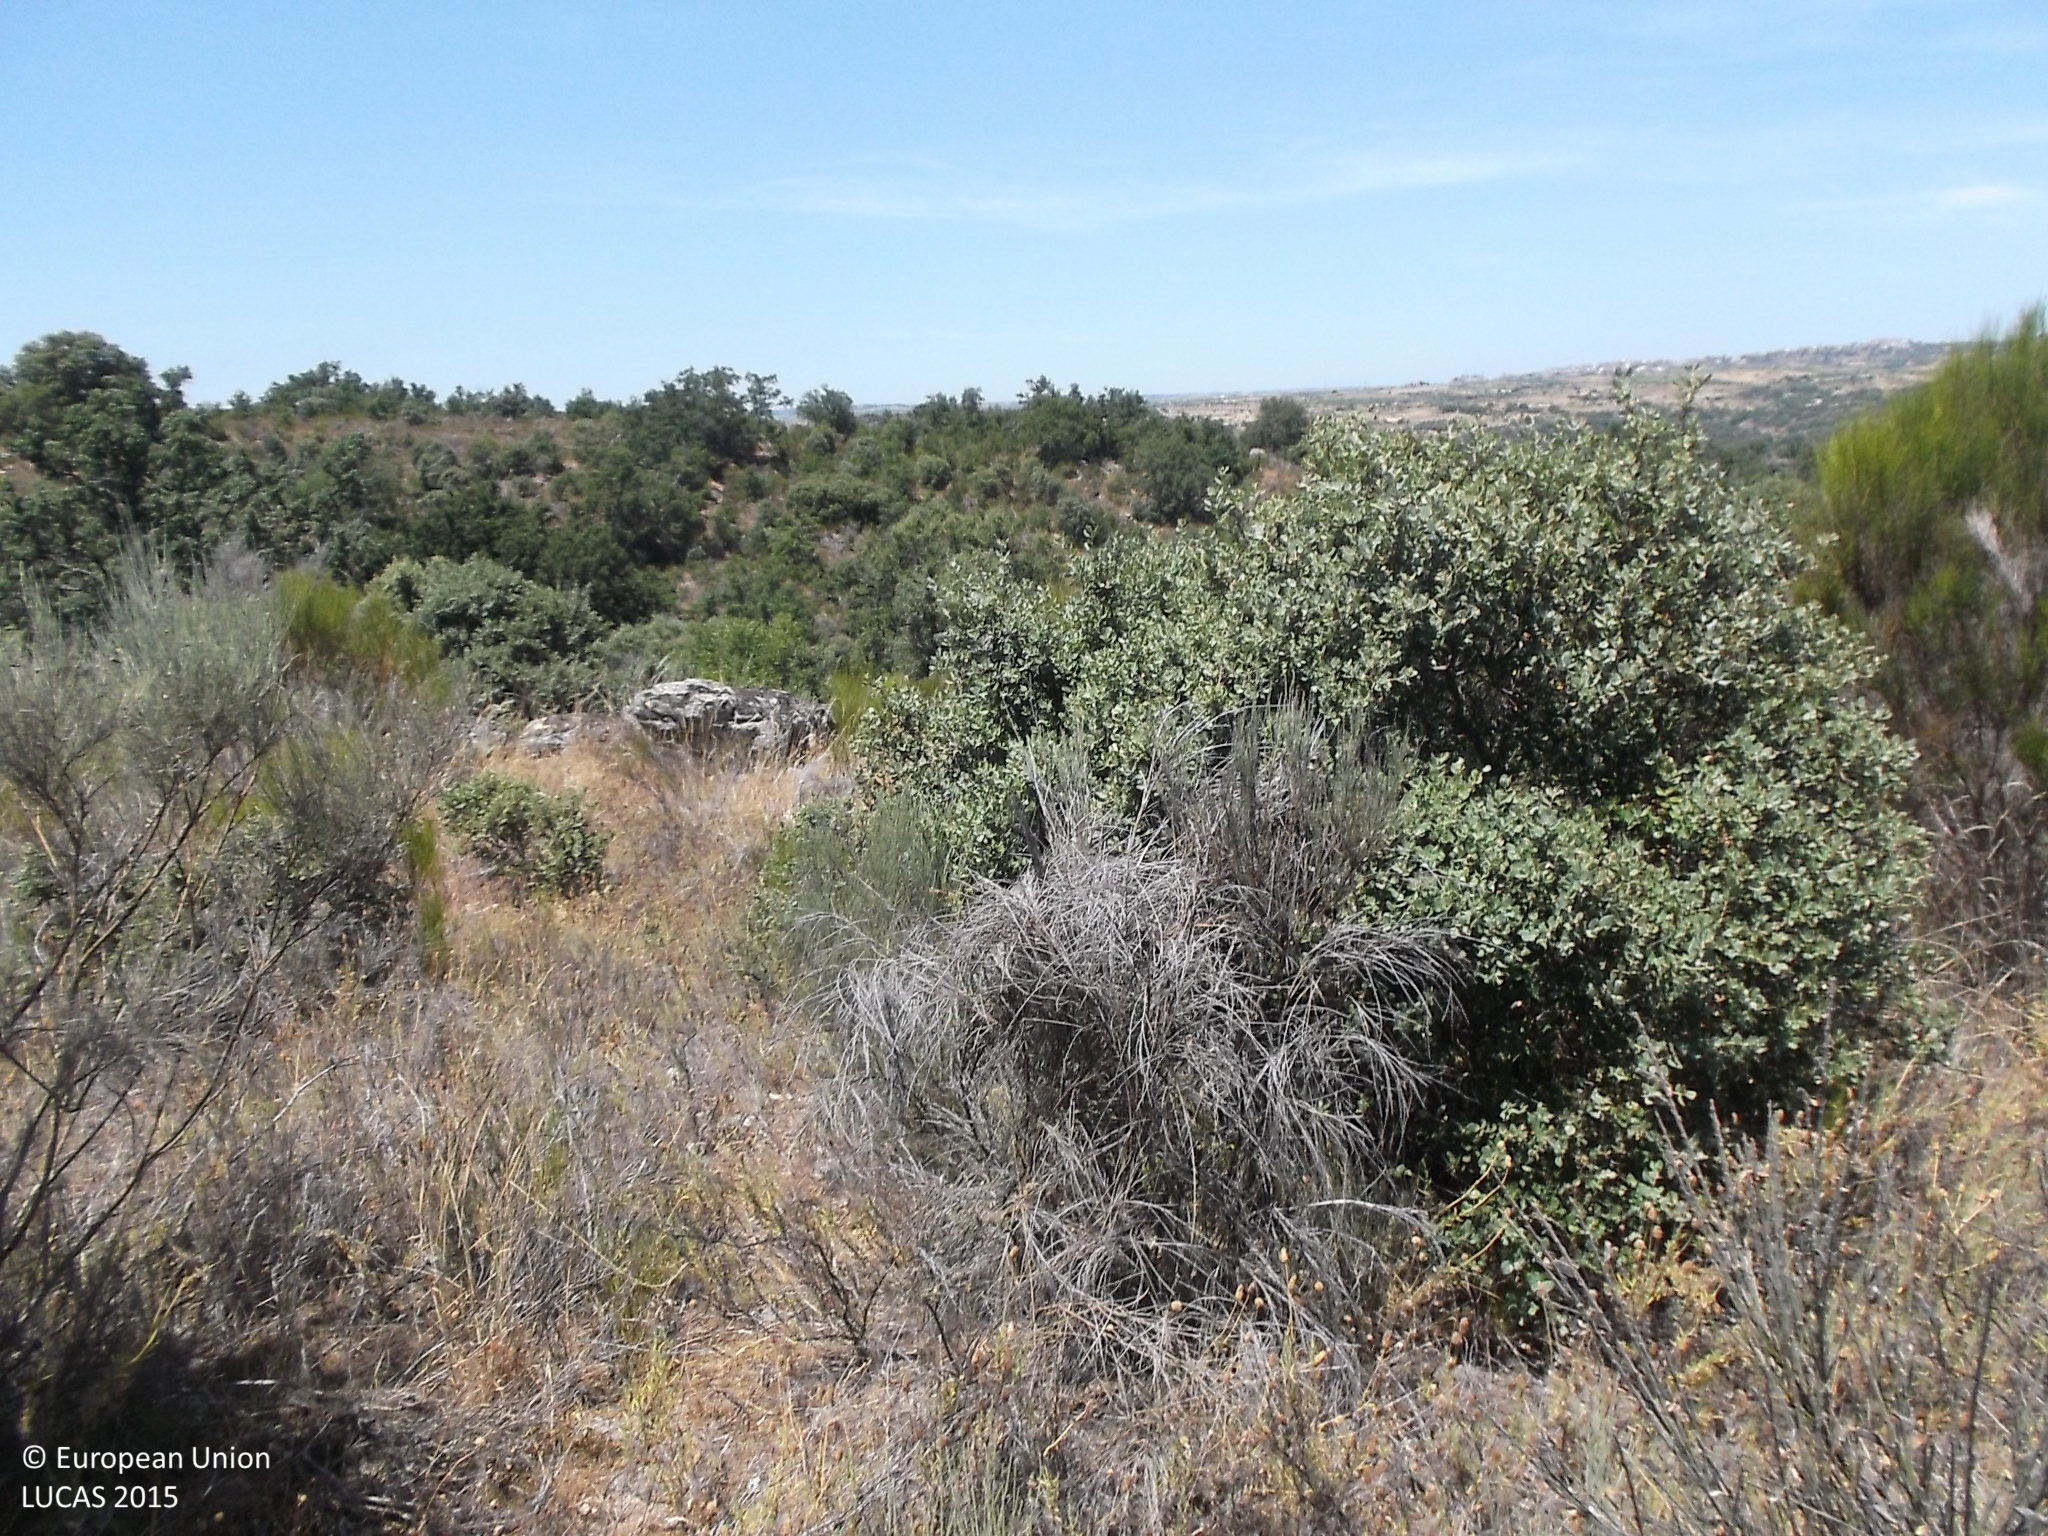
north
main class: Shrubland
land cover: Shrubland with sparse tree cover
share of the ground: > 75 %
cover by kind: shrubs 80 %, herbaceous plants 15 %, broadleaved forest trees 5 %
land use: Semi-natural and natural areas not in use
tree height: < 5 m
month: July
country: ES
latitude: 41.2712
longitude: -6.3917
